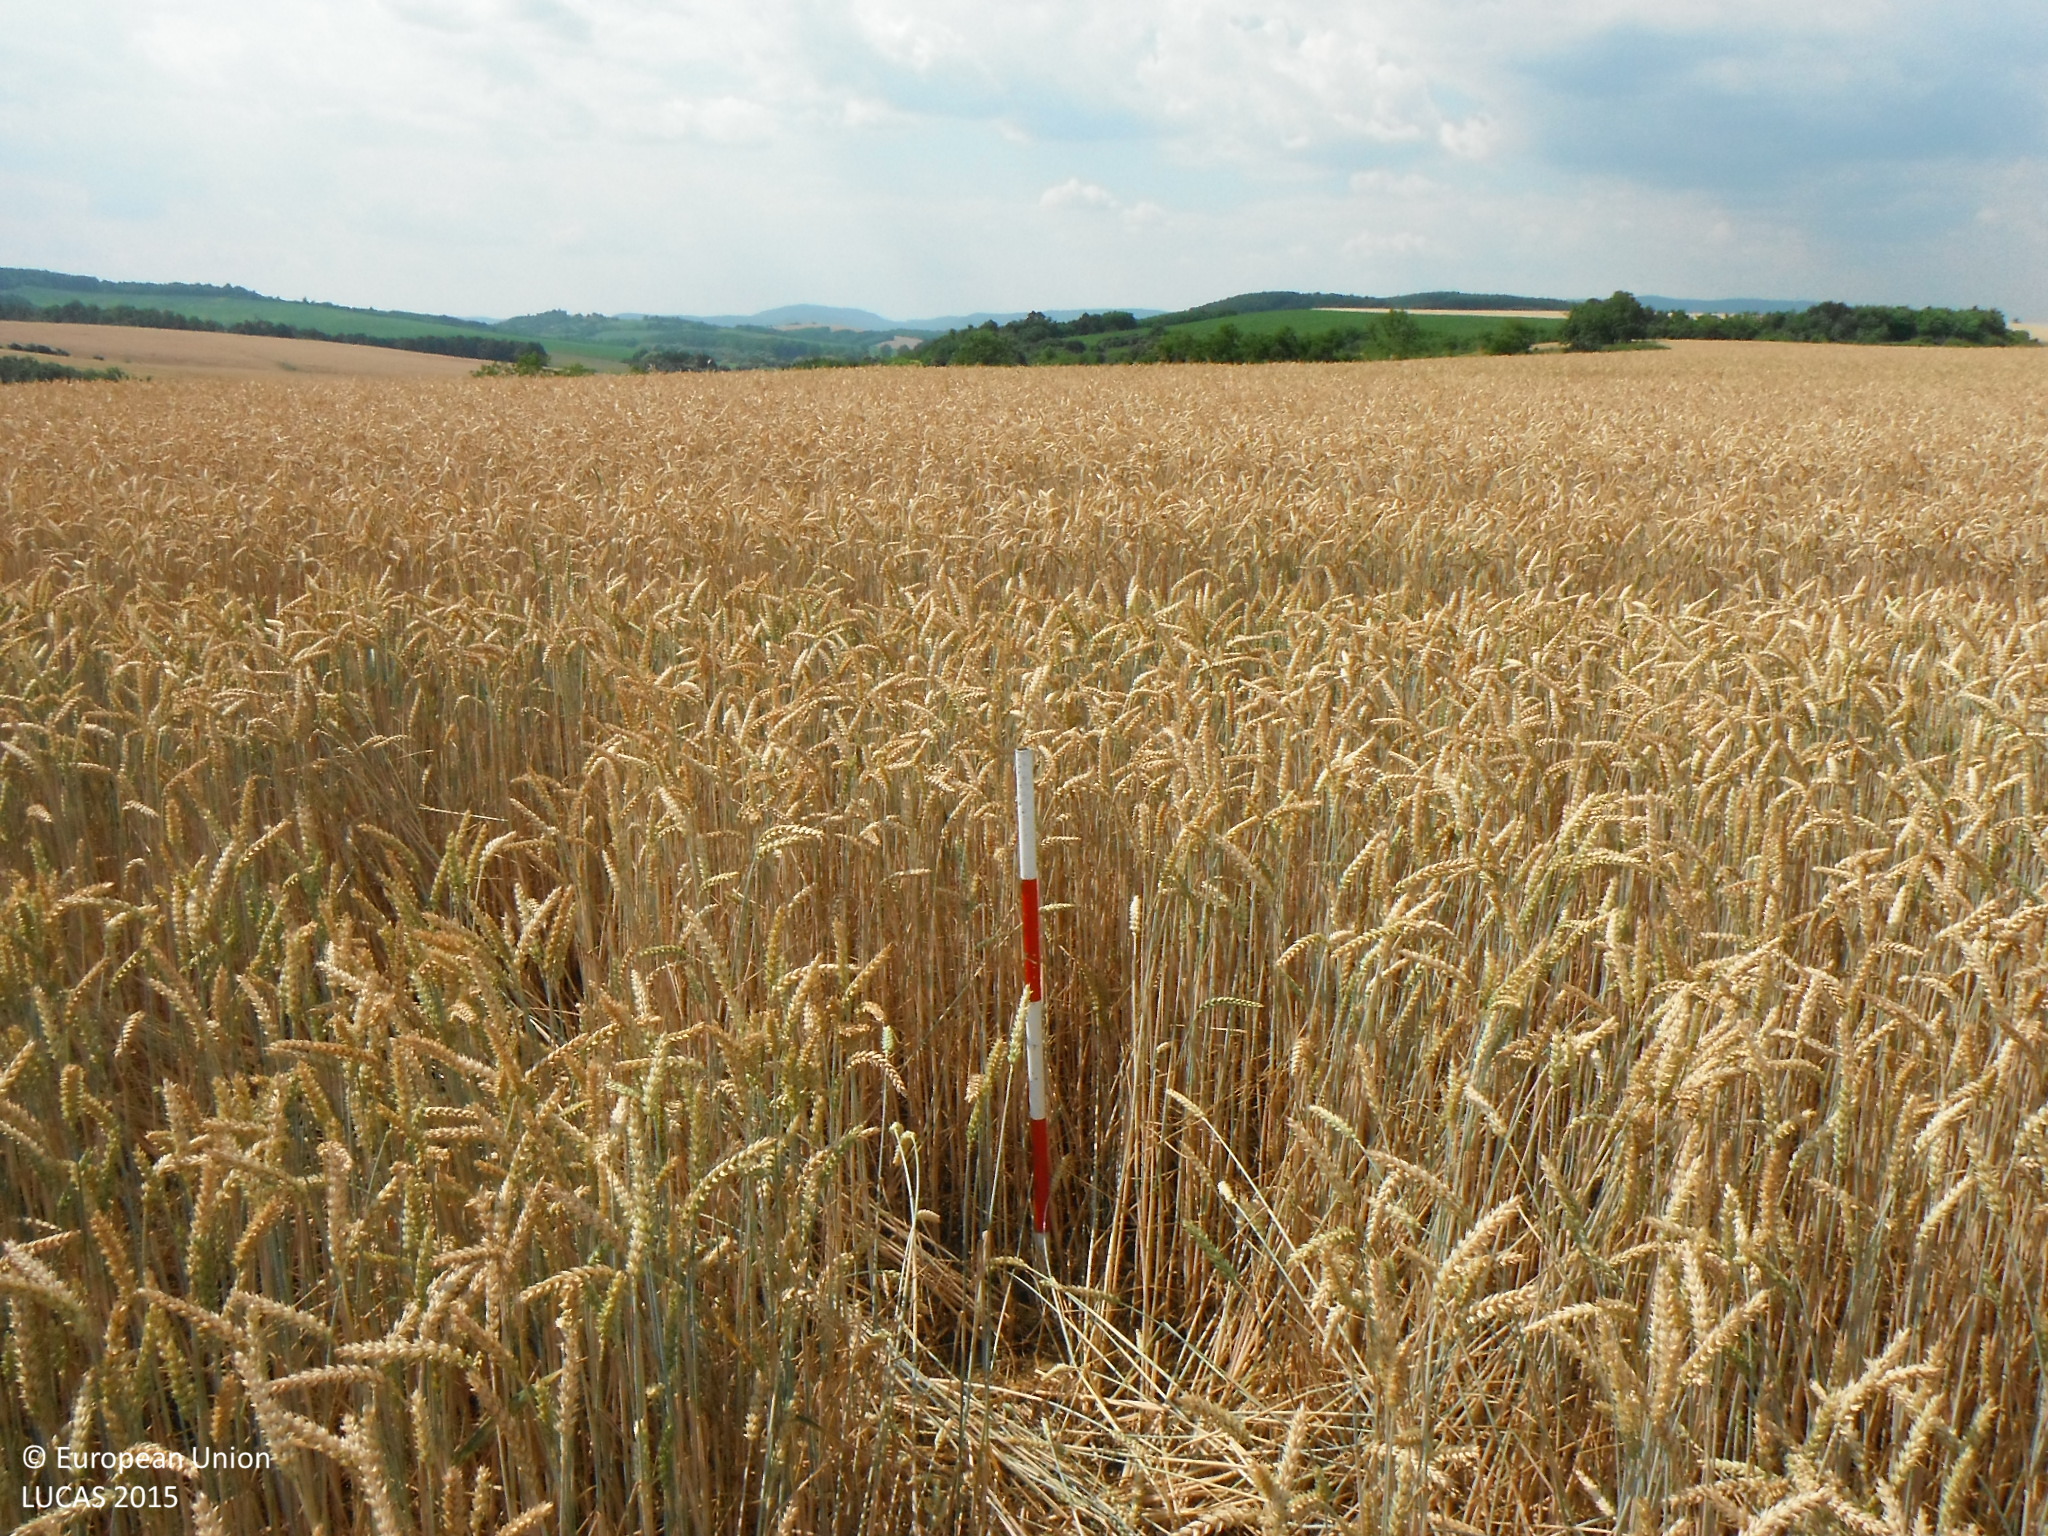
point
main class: Cropland
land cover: Common wheat
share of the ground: > 75 %
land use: Agriculture (excluding fallow land and kitchen gardens)
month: July
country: SK
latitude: 48.1168
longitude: 19.3312
